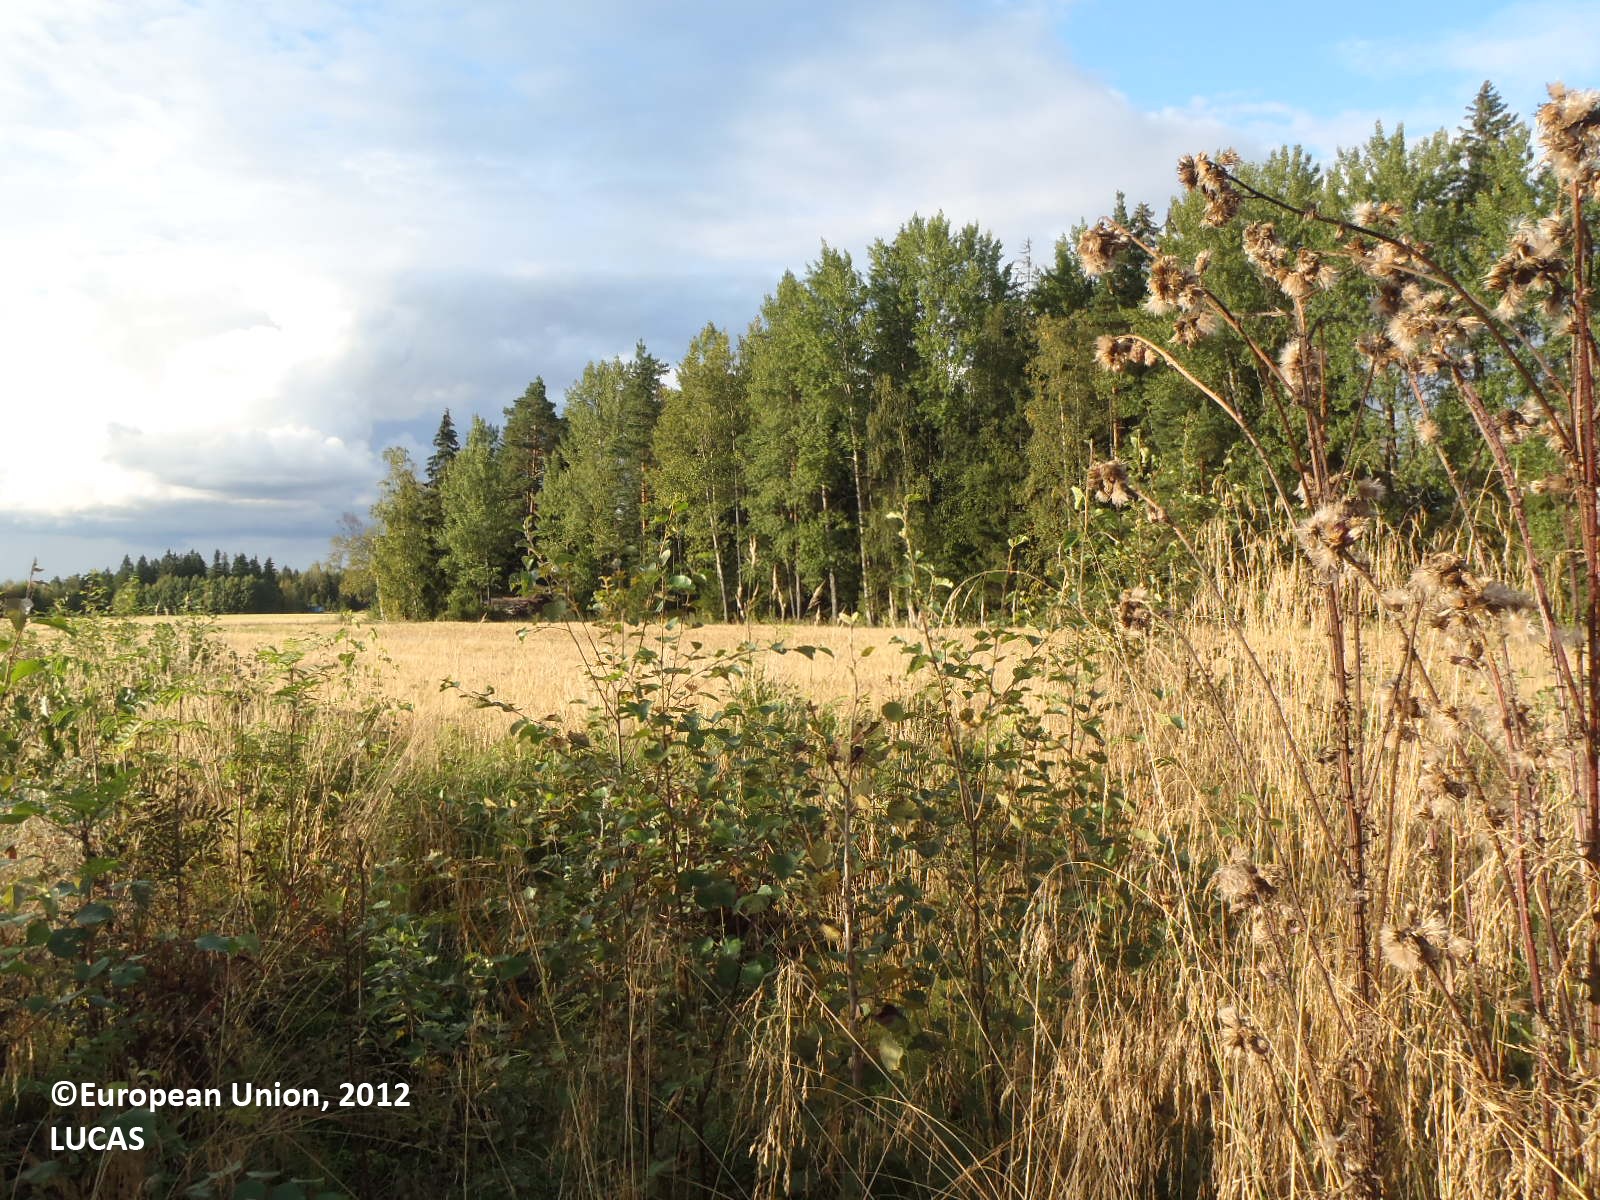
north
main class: Woodland
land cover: Broadleaved woodland
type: boreal forest
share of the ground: 10 - 25 %
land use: Forestry
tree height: < 5 m
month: August
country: FI
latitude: 60.6137
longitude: 22.4370
